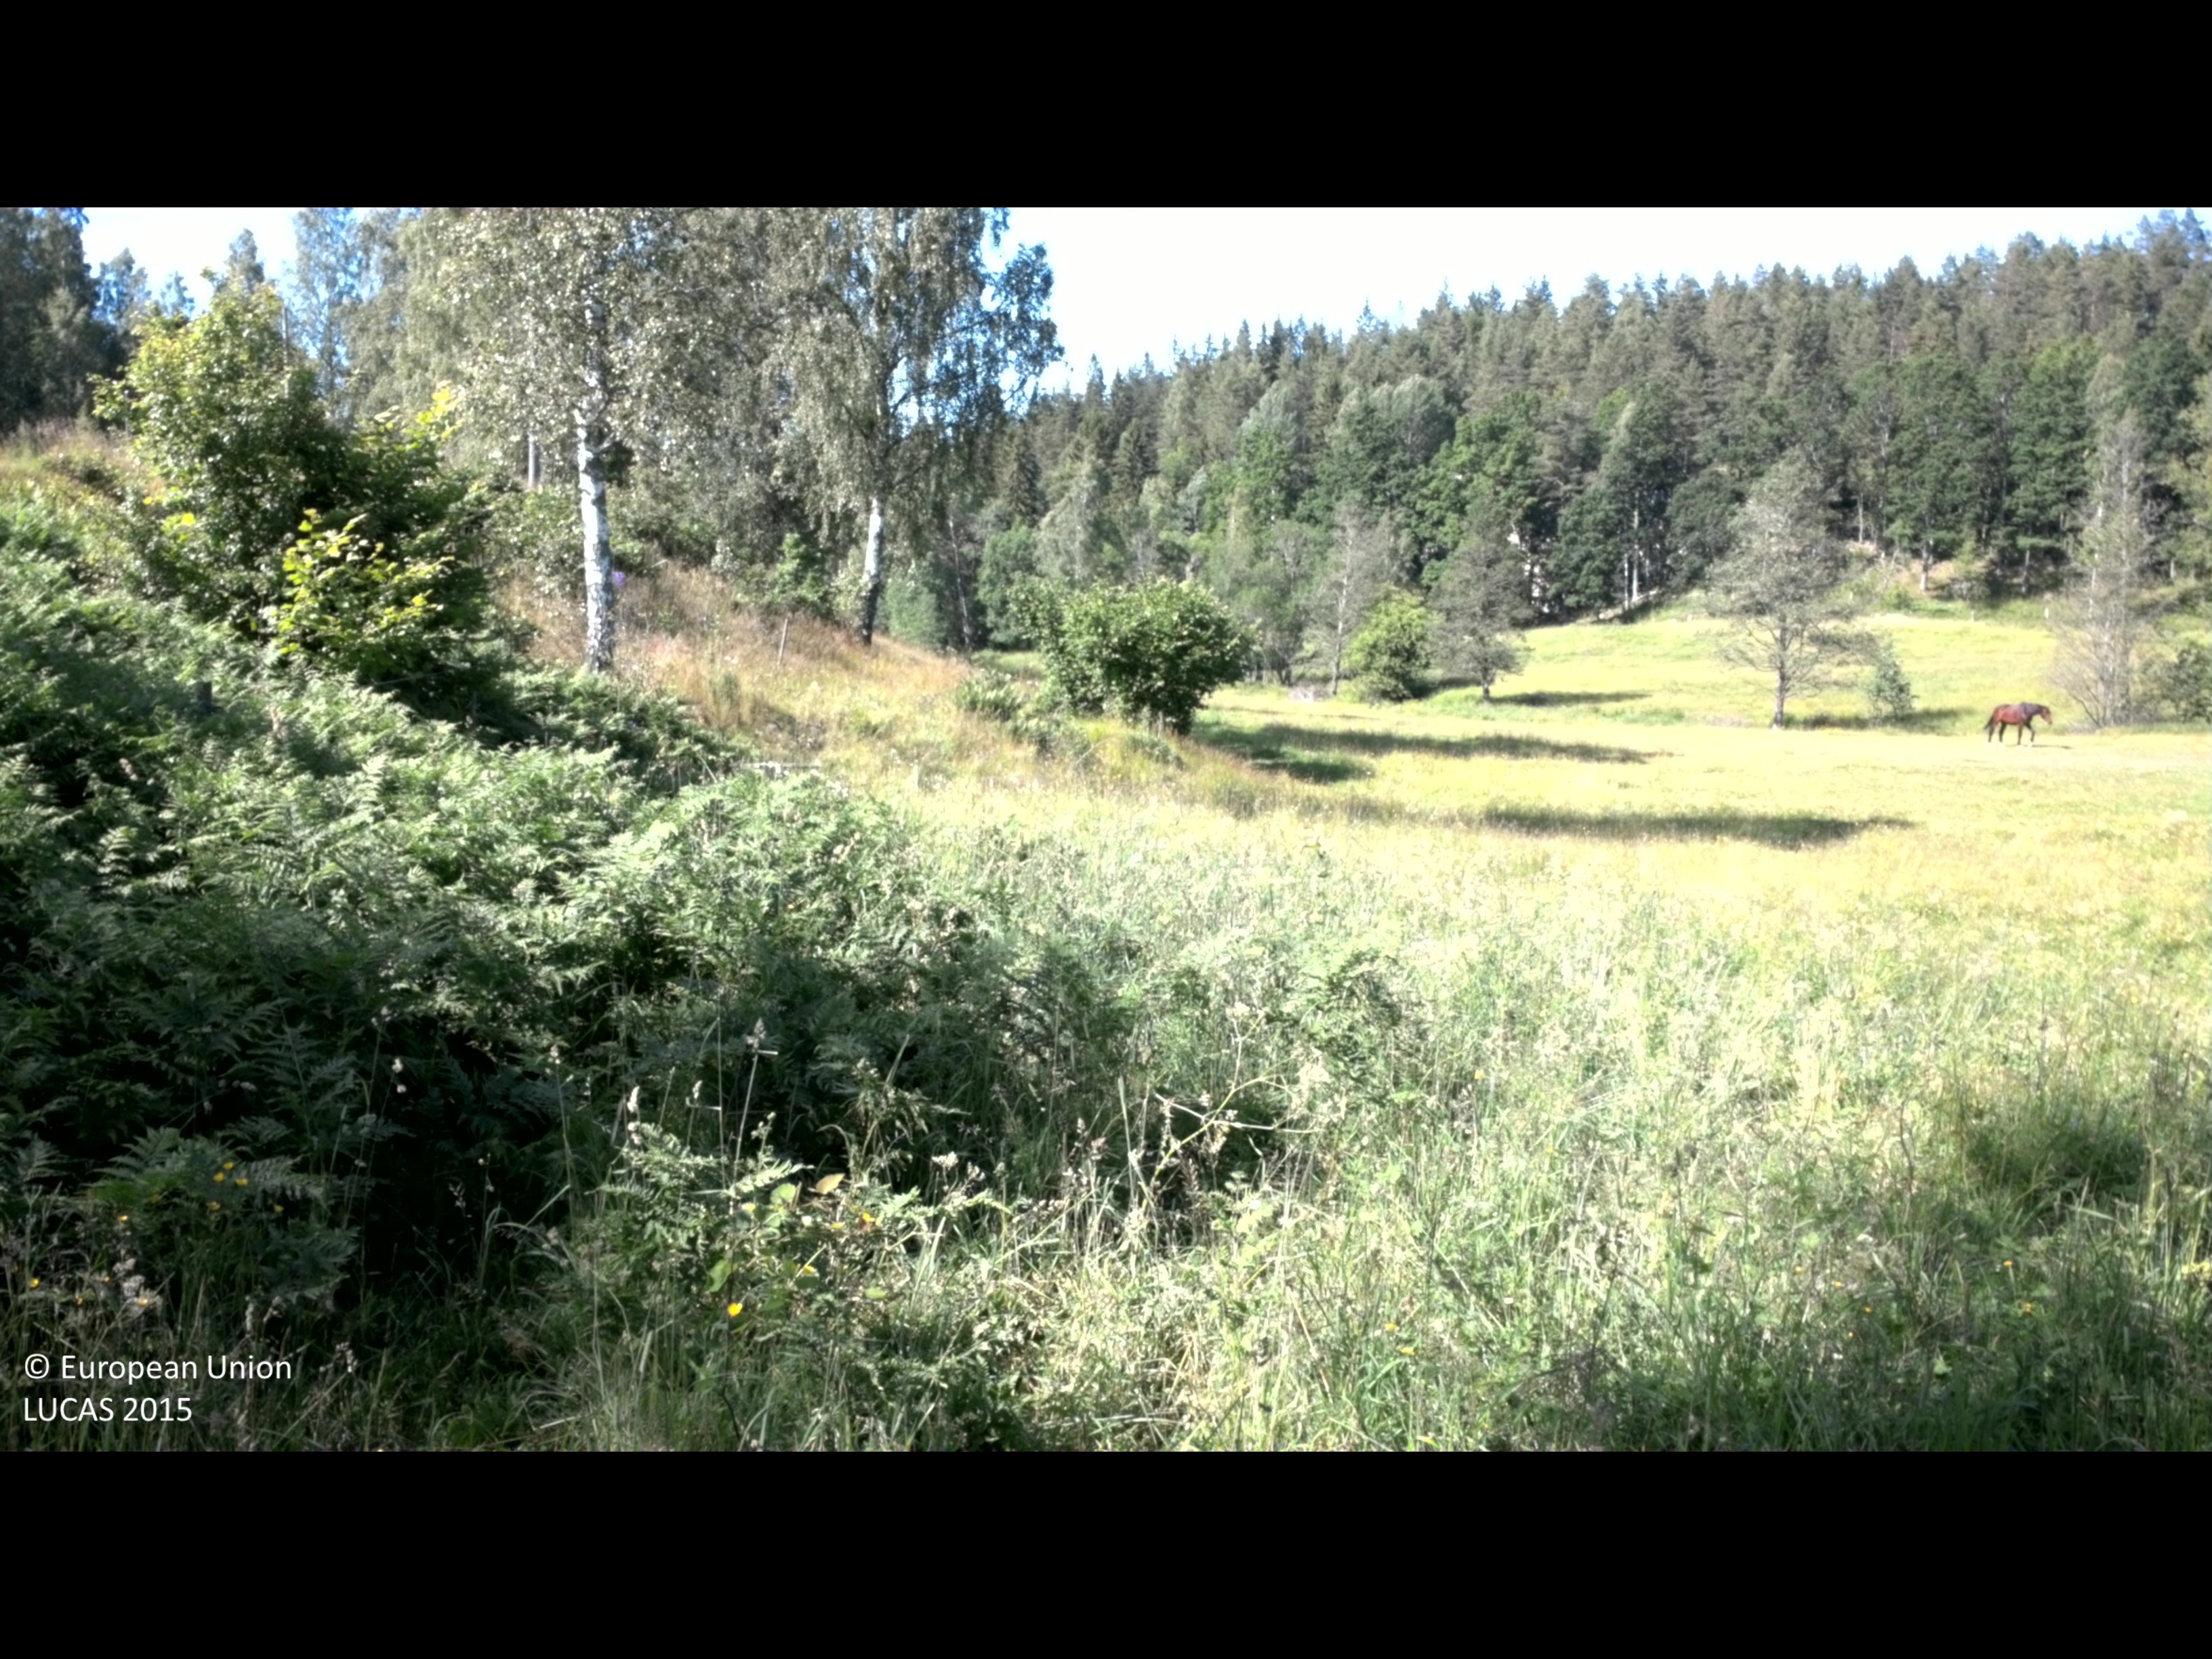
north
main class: Grassland
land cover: Grassland without tree/shrub cover
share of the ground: > 75 %
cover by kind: herbaceous plants 95 %, shrubs 5 %
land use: Agriculture (excluding fallow land and kitchen gardens)
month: June
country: SE
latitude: 58.2040
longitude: 16.1731
